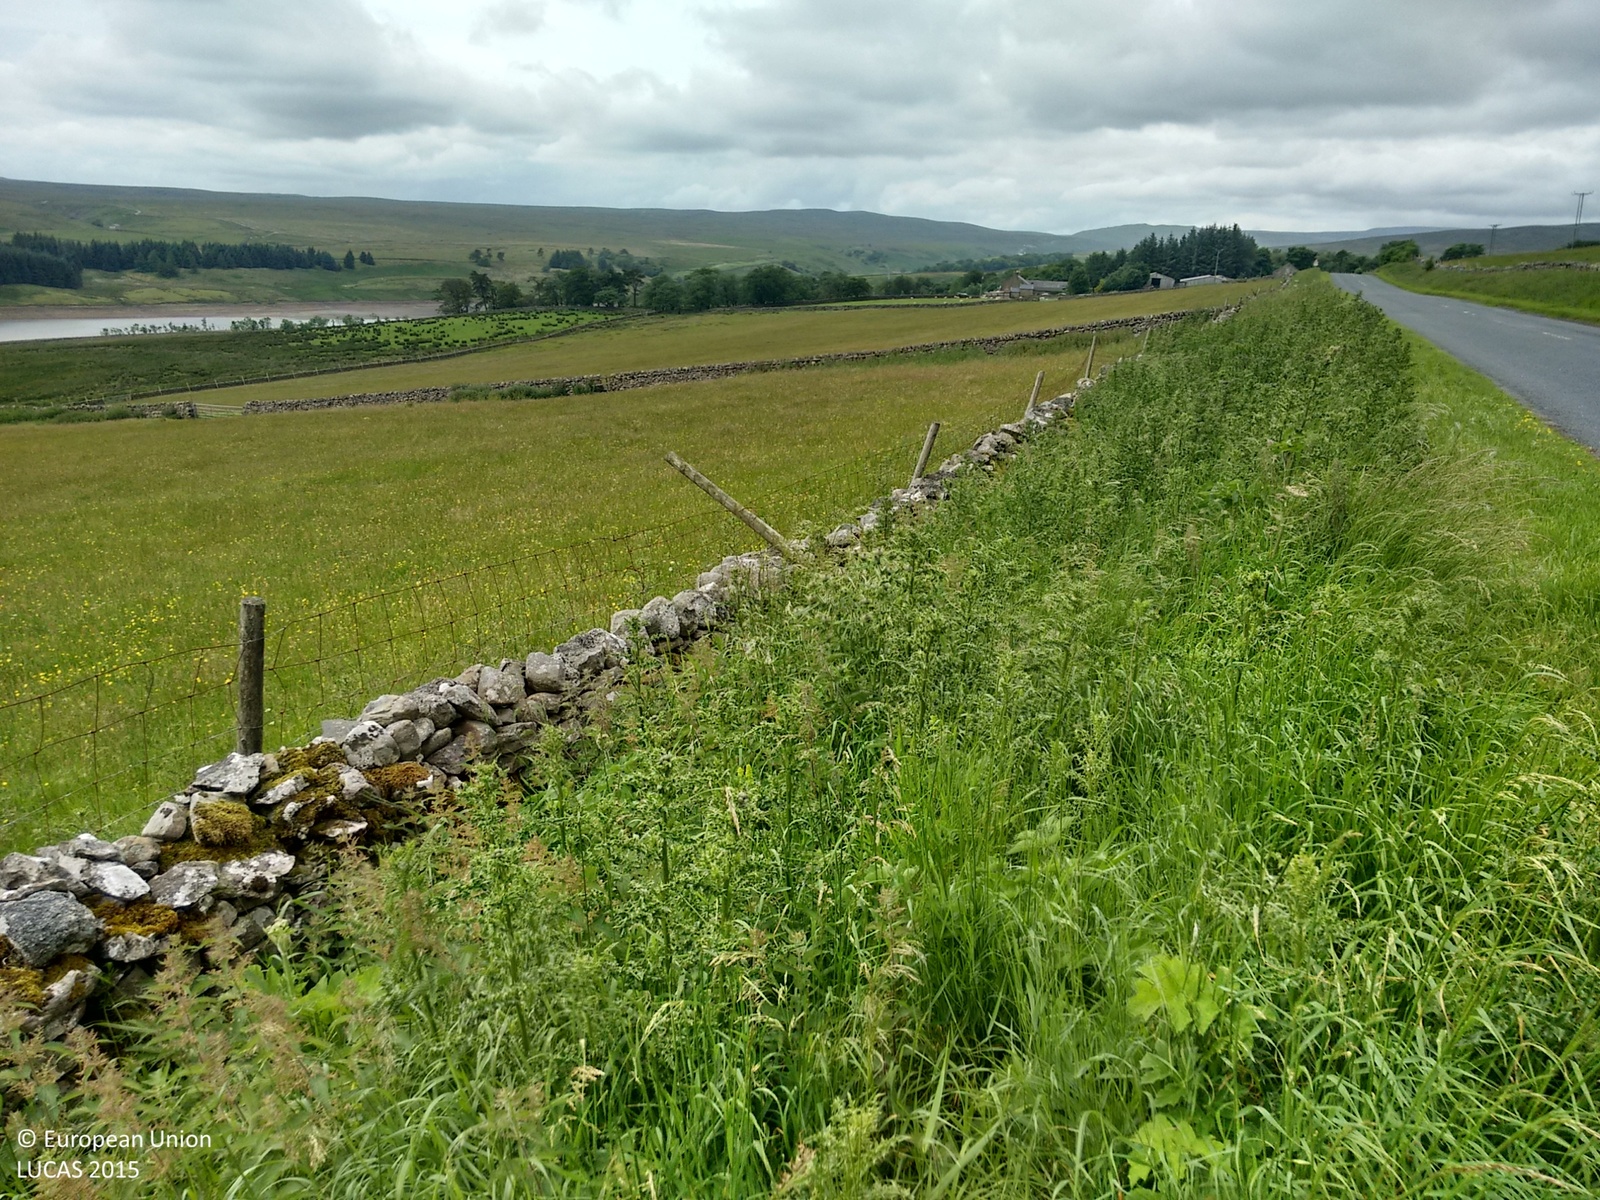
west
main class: Grassland
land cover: Grassland without tree/shrub cover
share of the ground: > 75 %
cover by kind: herbaceous plants 100 %
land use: Water supply and treatment
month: July
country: GB
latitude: 54.5892
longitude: -2.1439
